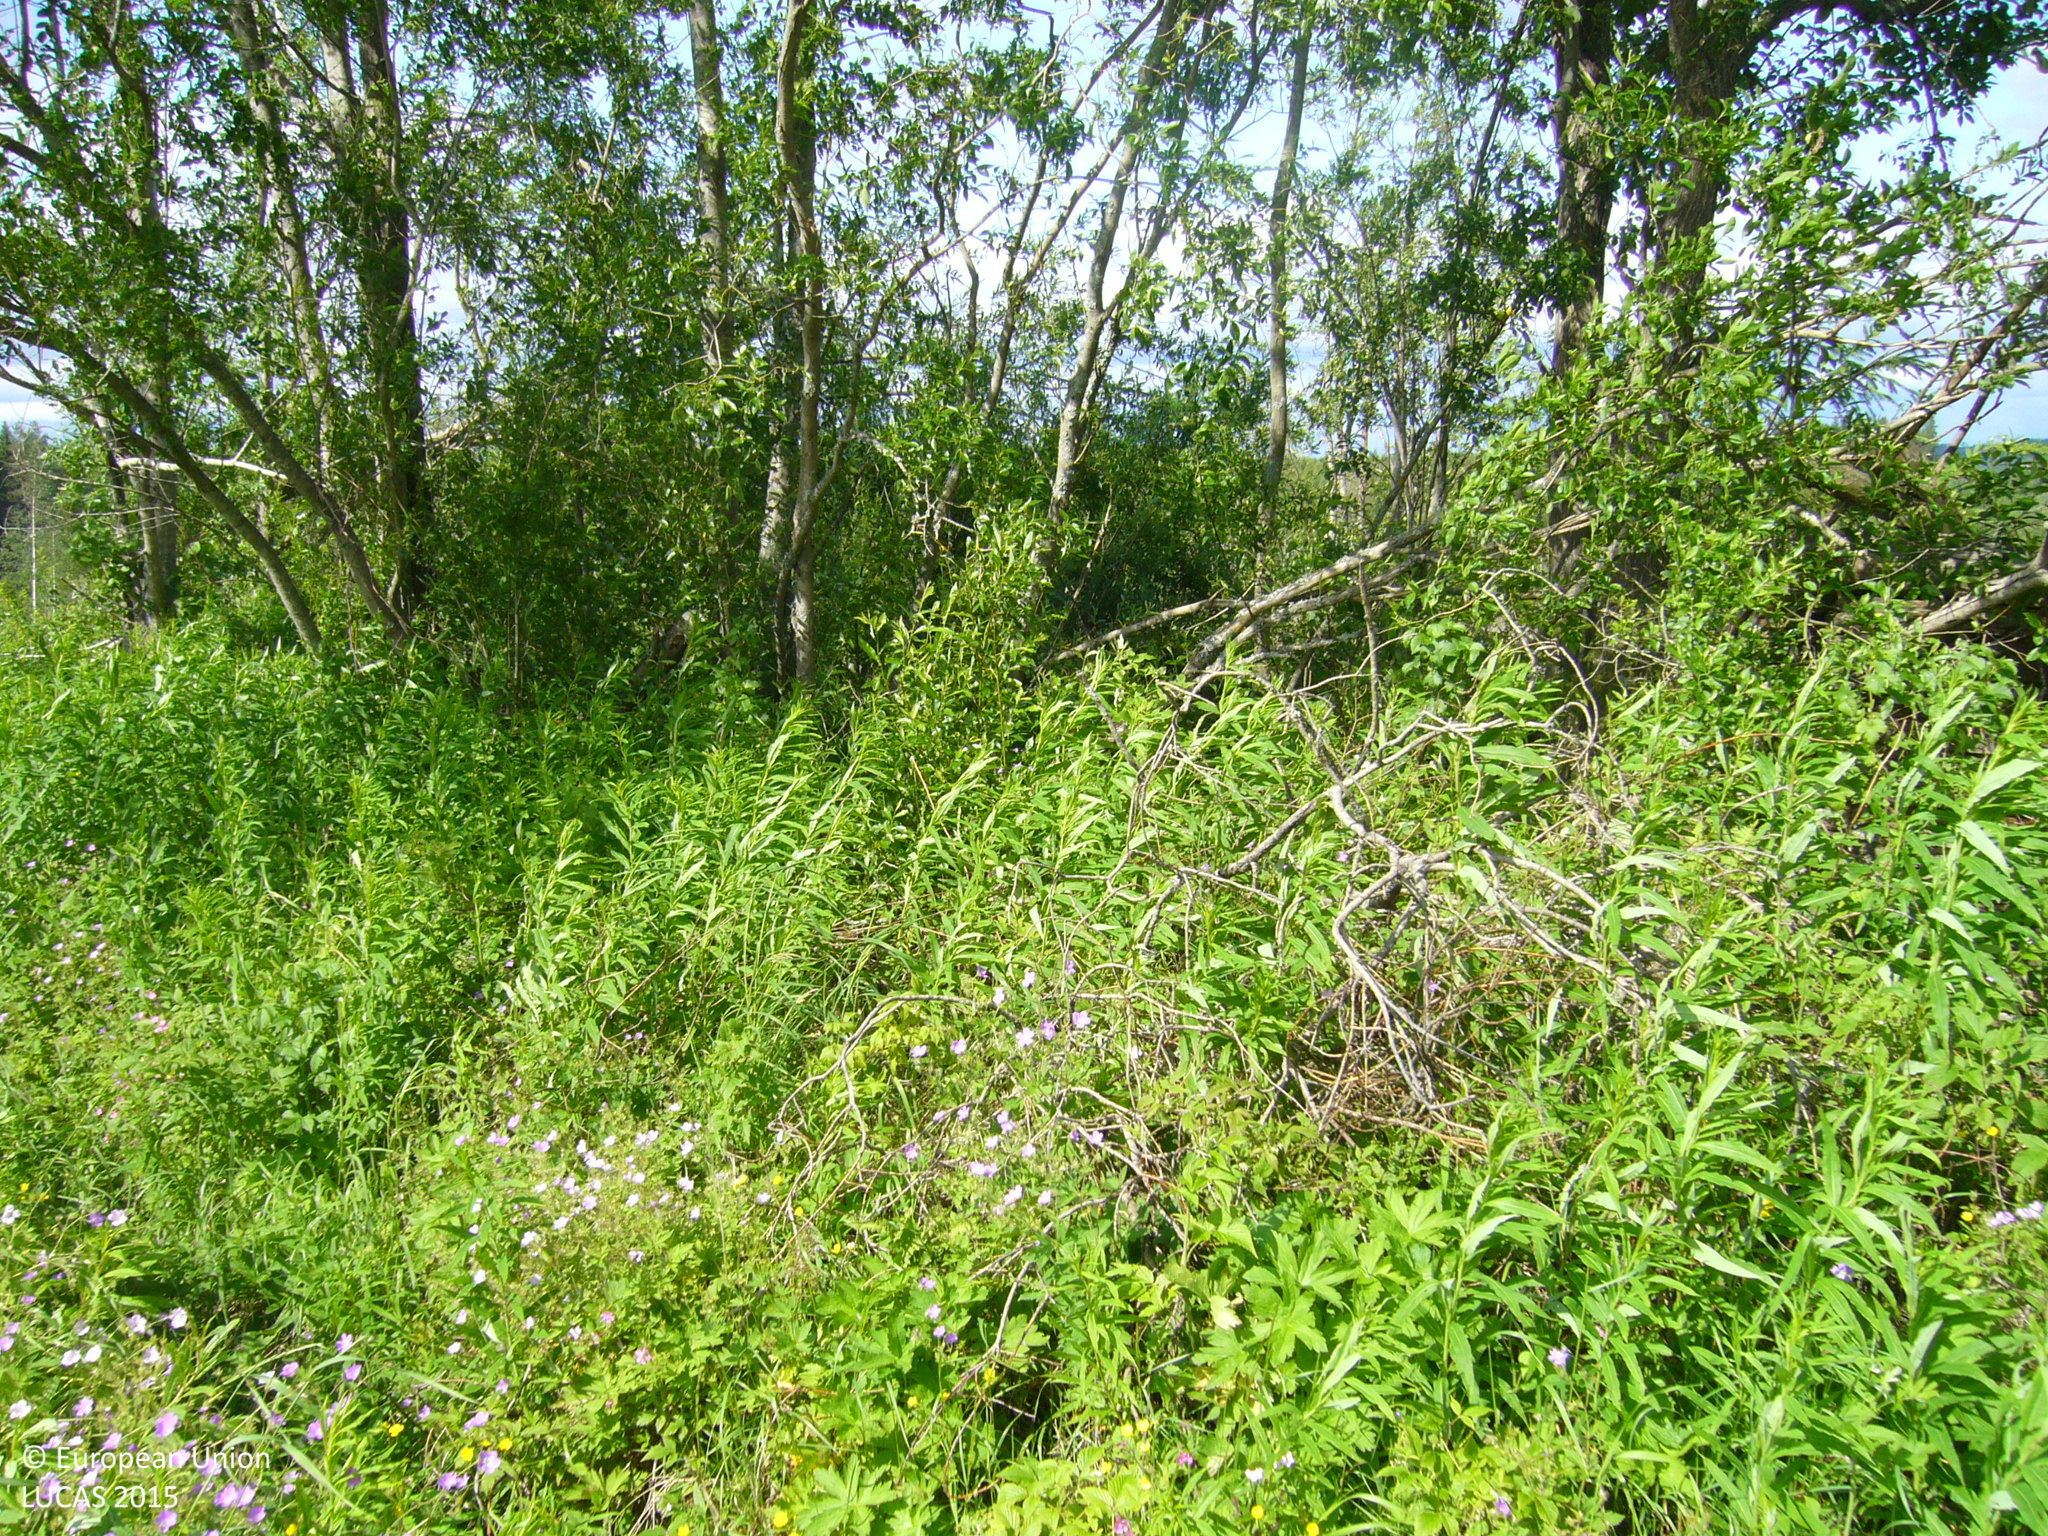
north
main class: Grassland
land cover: Grassland without tree/shrub cover
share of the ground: > 75 %
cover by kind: herbaceous plants 100 %
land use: Agriculture (excluding fallow land and kitchen gardens)
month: July
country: FI
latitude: 63.2561
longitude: 26.0726
